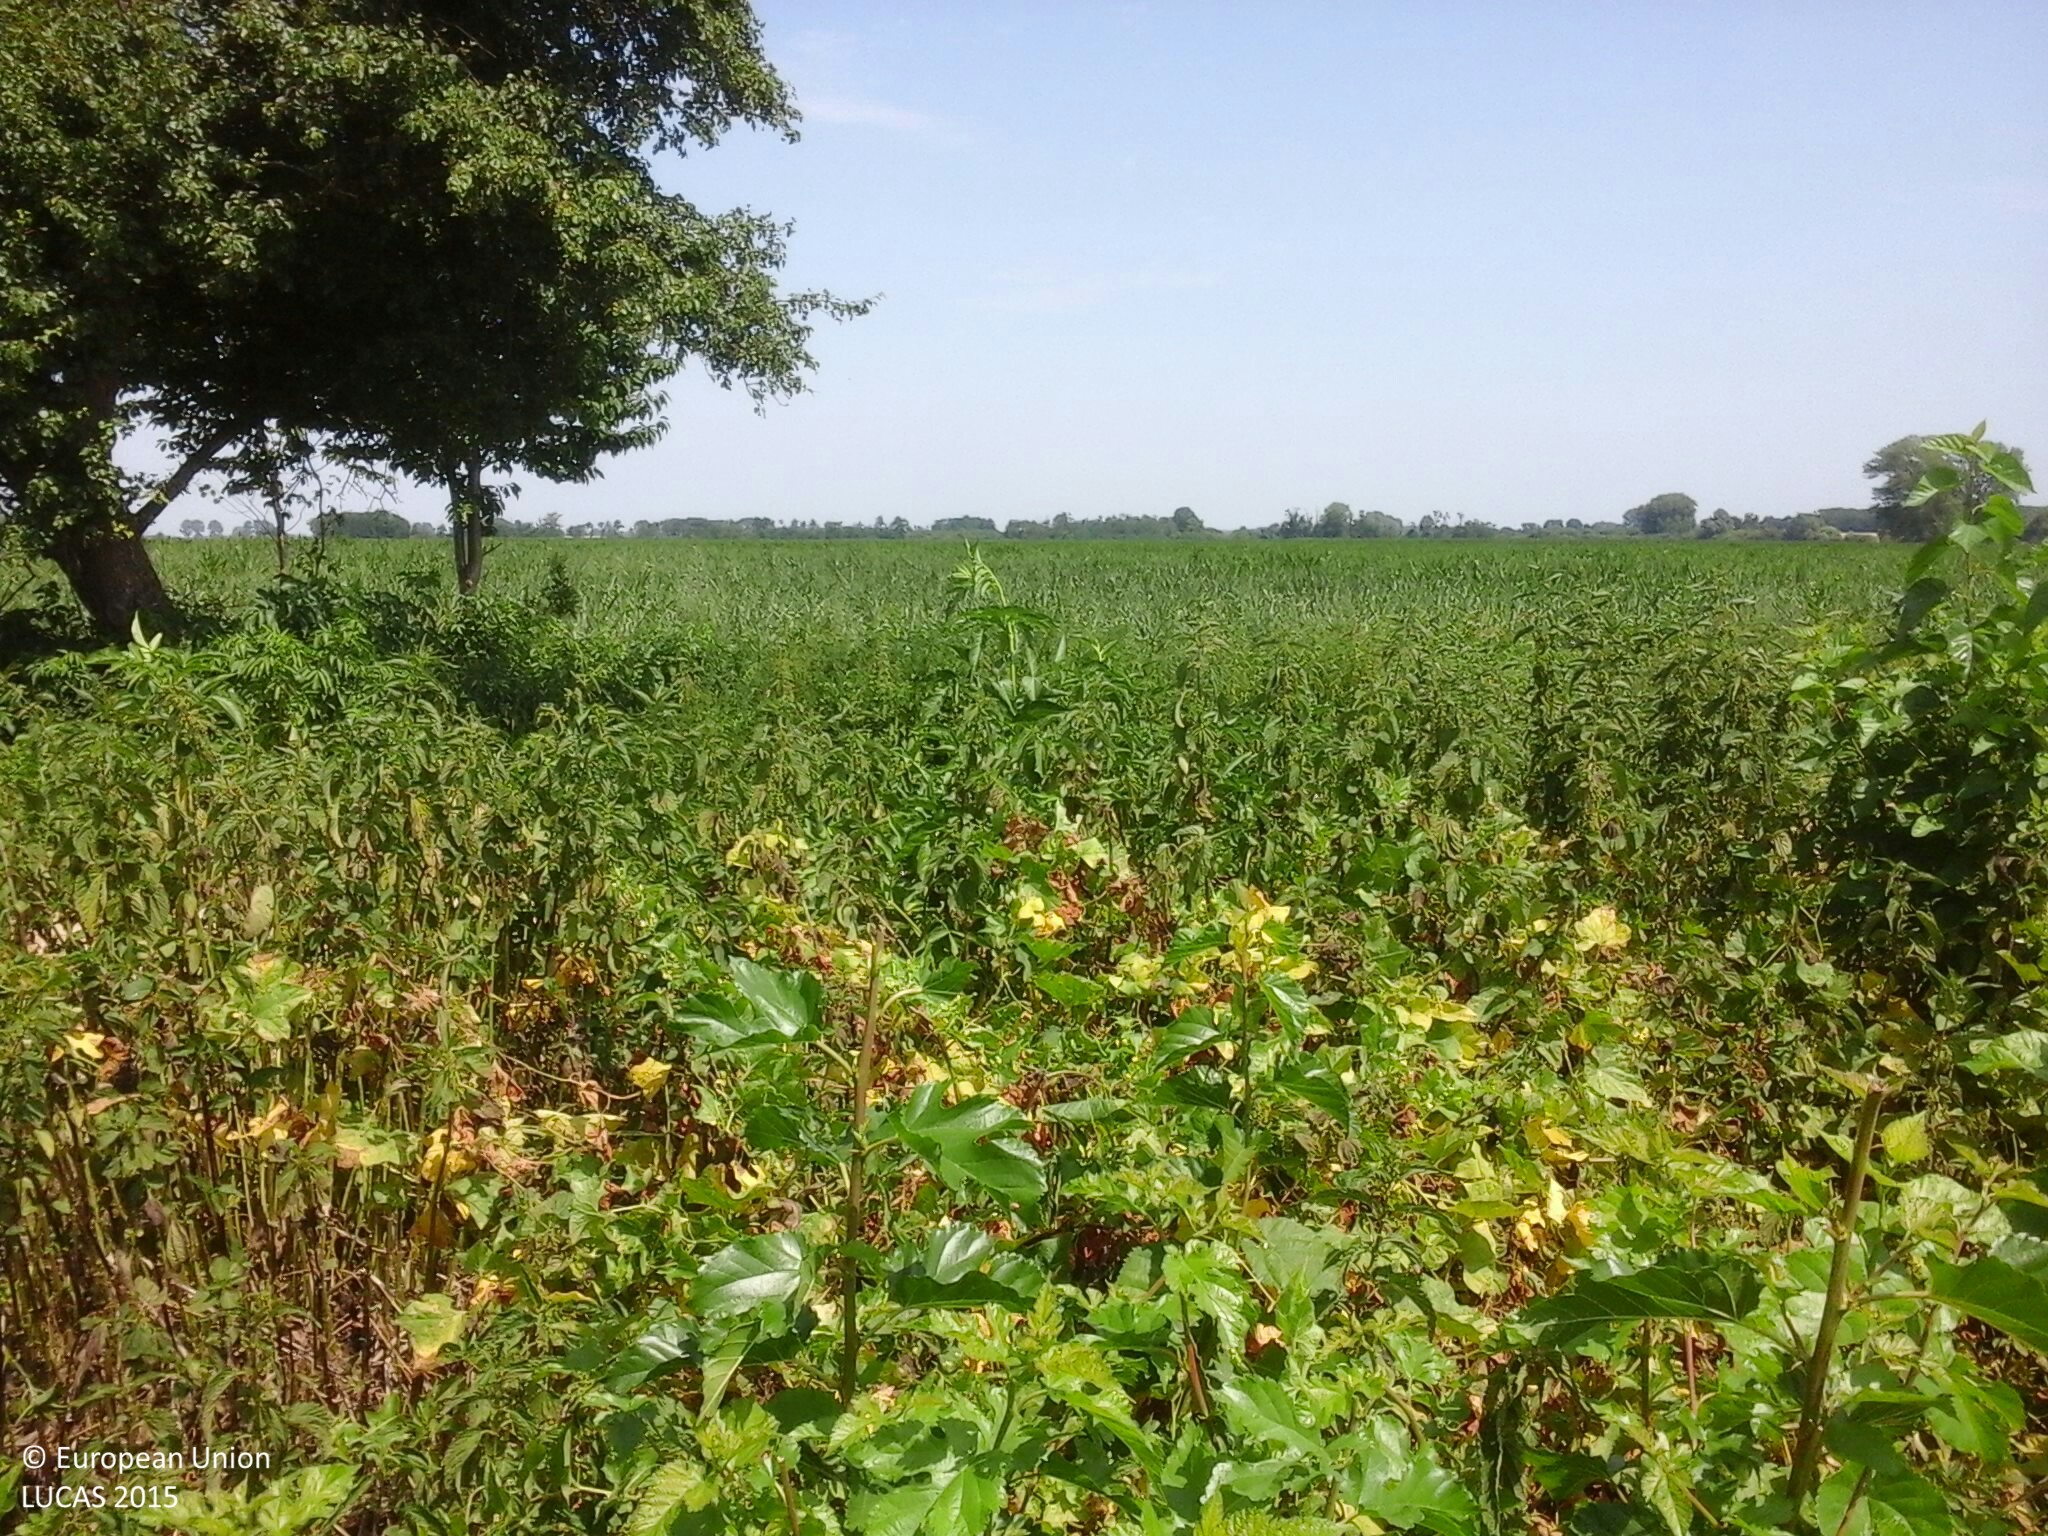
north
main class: Shrubland
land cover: Shrubland with sparse tree cover
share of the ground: 50 - 75 %
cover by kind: herbaceous plants 50 %, shrubs 45 %, broadleaved forest trees 5 %
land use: Semi-natural and natural areas not in use
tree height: < 5 m
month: July
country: HU
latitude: 47.2004
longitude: 17.3591
